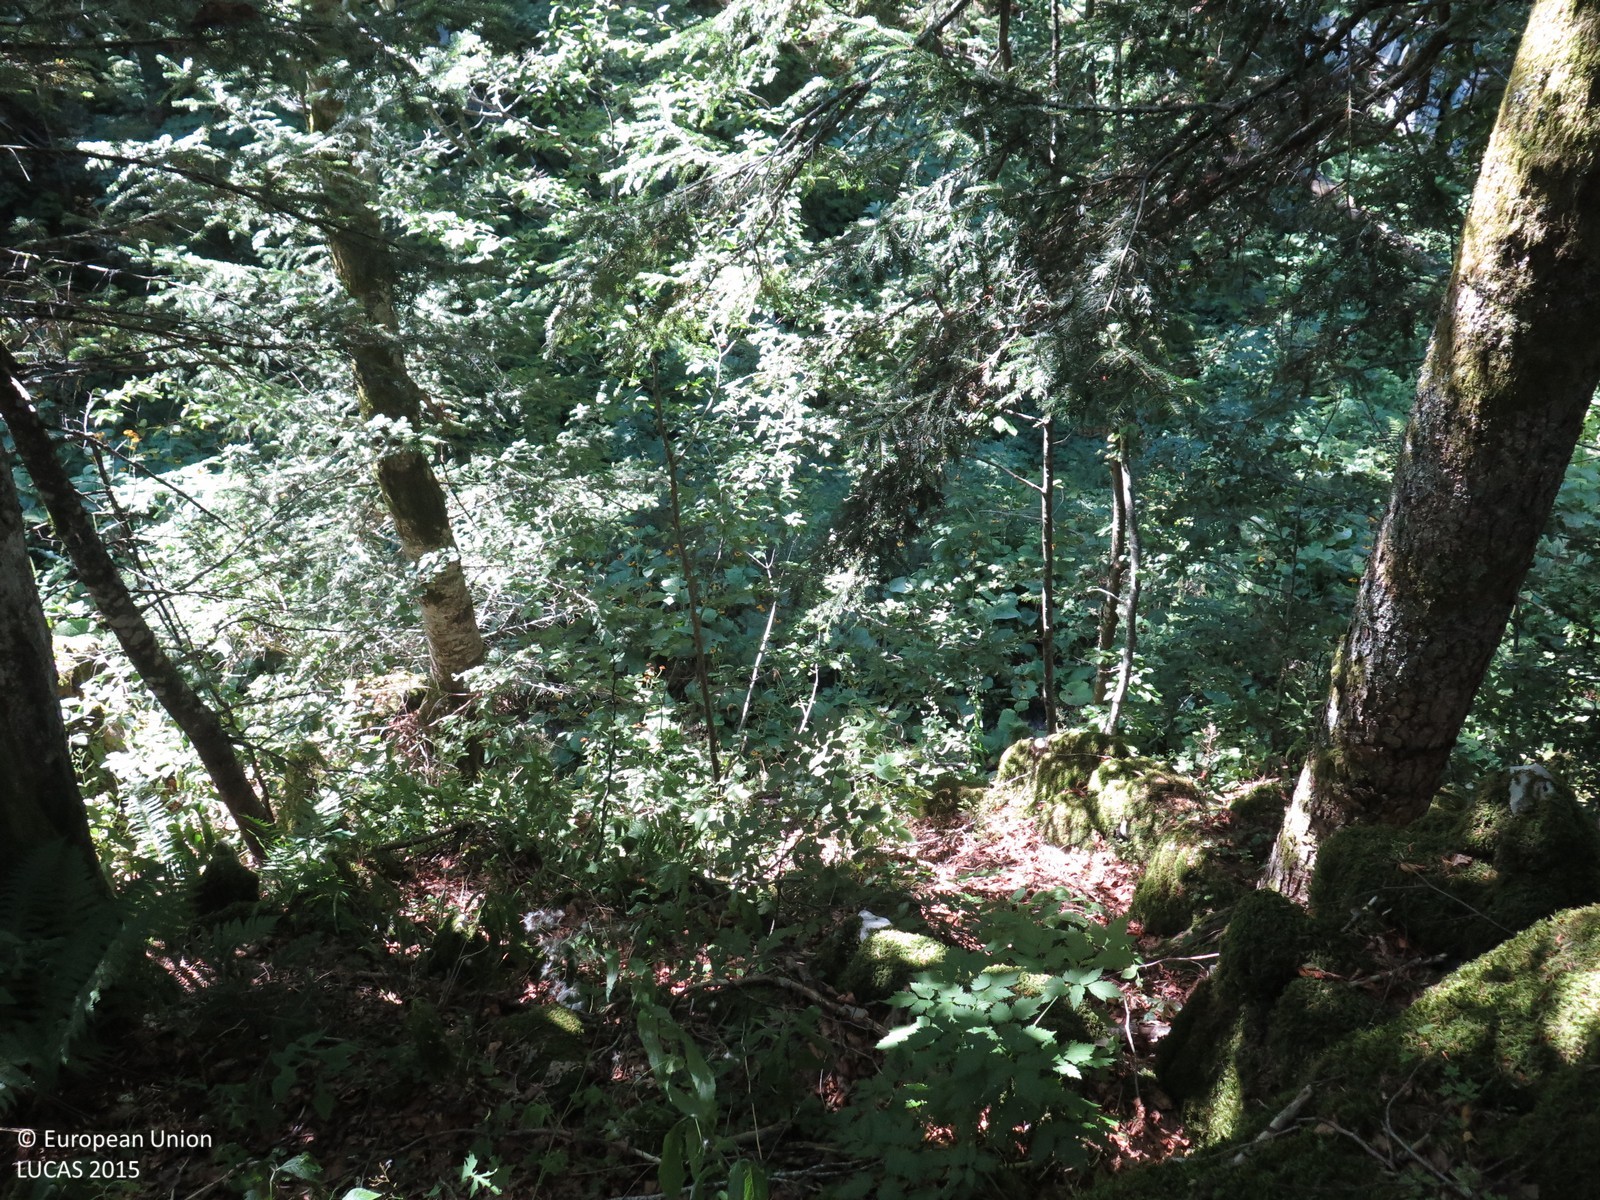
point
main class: Woodland
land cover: Other mixed woodland
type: mountainous beech forest
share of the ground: > 75 %
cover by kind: coniferous forest trees 75 %, broadleaved forest trees 25 %
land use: Forestry
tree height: > 5 m
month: August
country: HR
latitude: 45.2486
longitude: 14.8493
